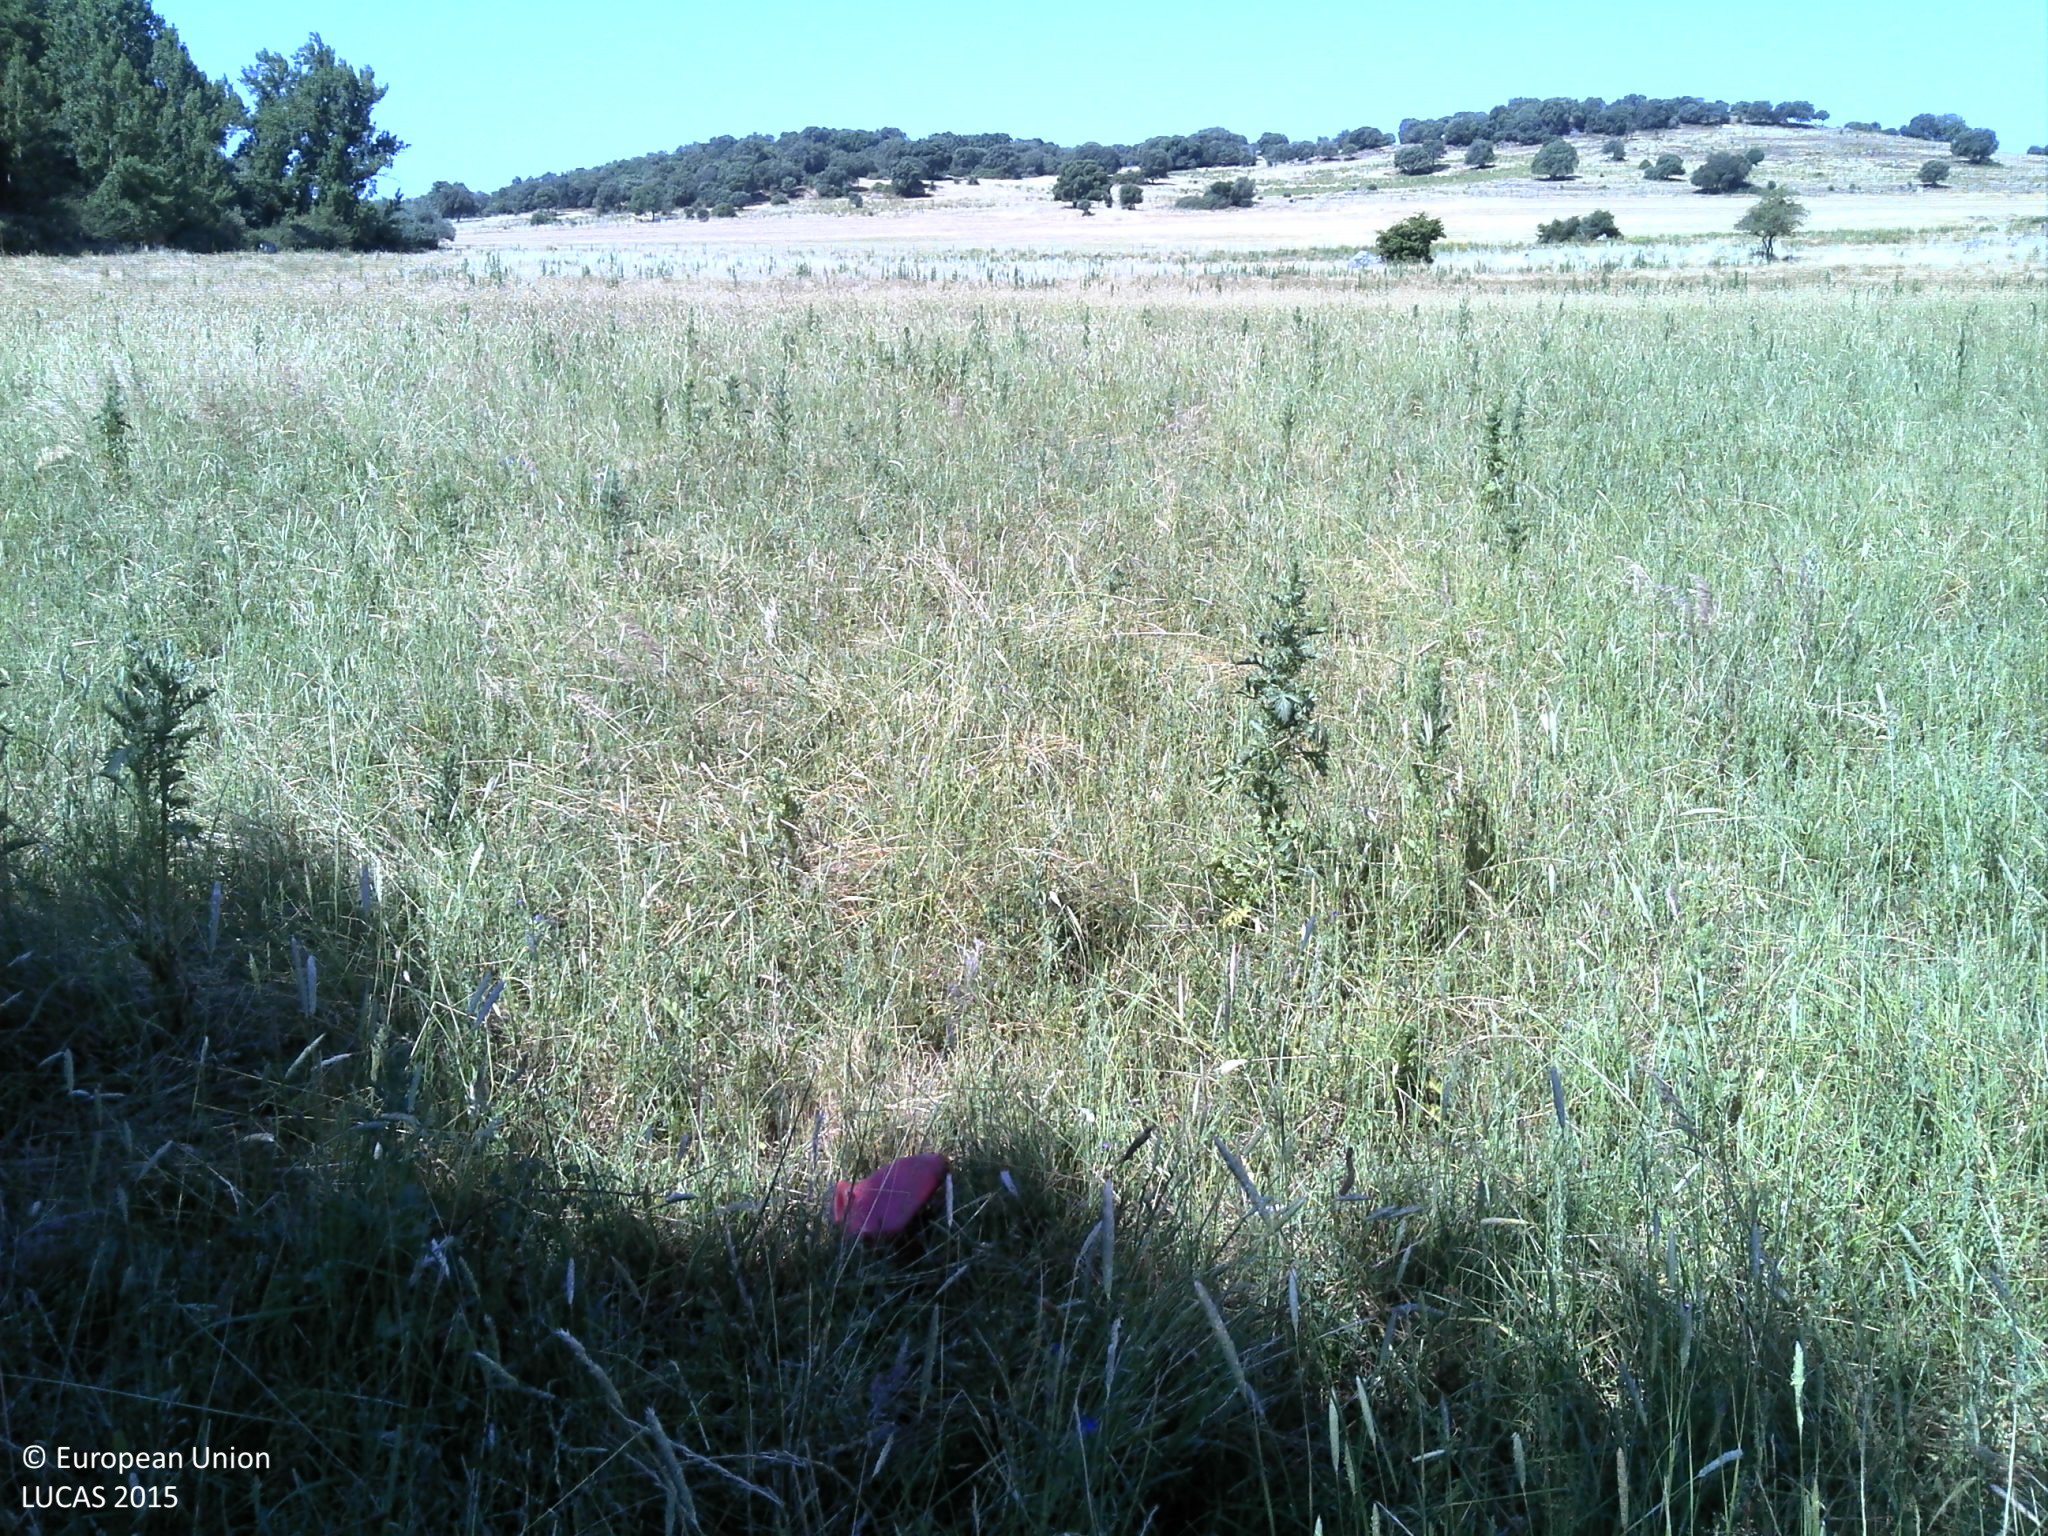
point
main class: Grassland
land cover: Grassland with sparse tree/shrub cover
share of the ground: > 75 %
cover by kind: herbaceous plants 90 %, broadleaved forest trees 5 %, unconsolidated bare surface 5 %
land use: Agriculture (excluding fallow land and kitchen gardens)
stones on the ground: < 10 %
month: June
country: PT
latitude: 38.6865
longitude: -8.0599
